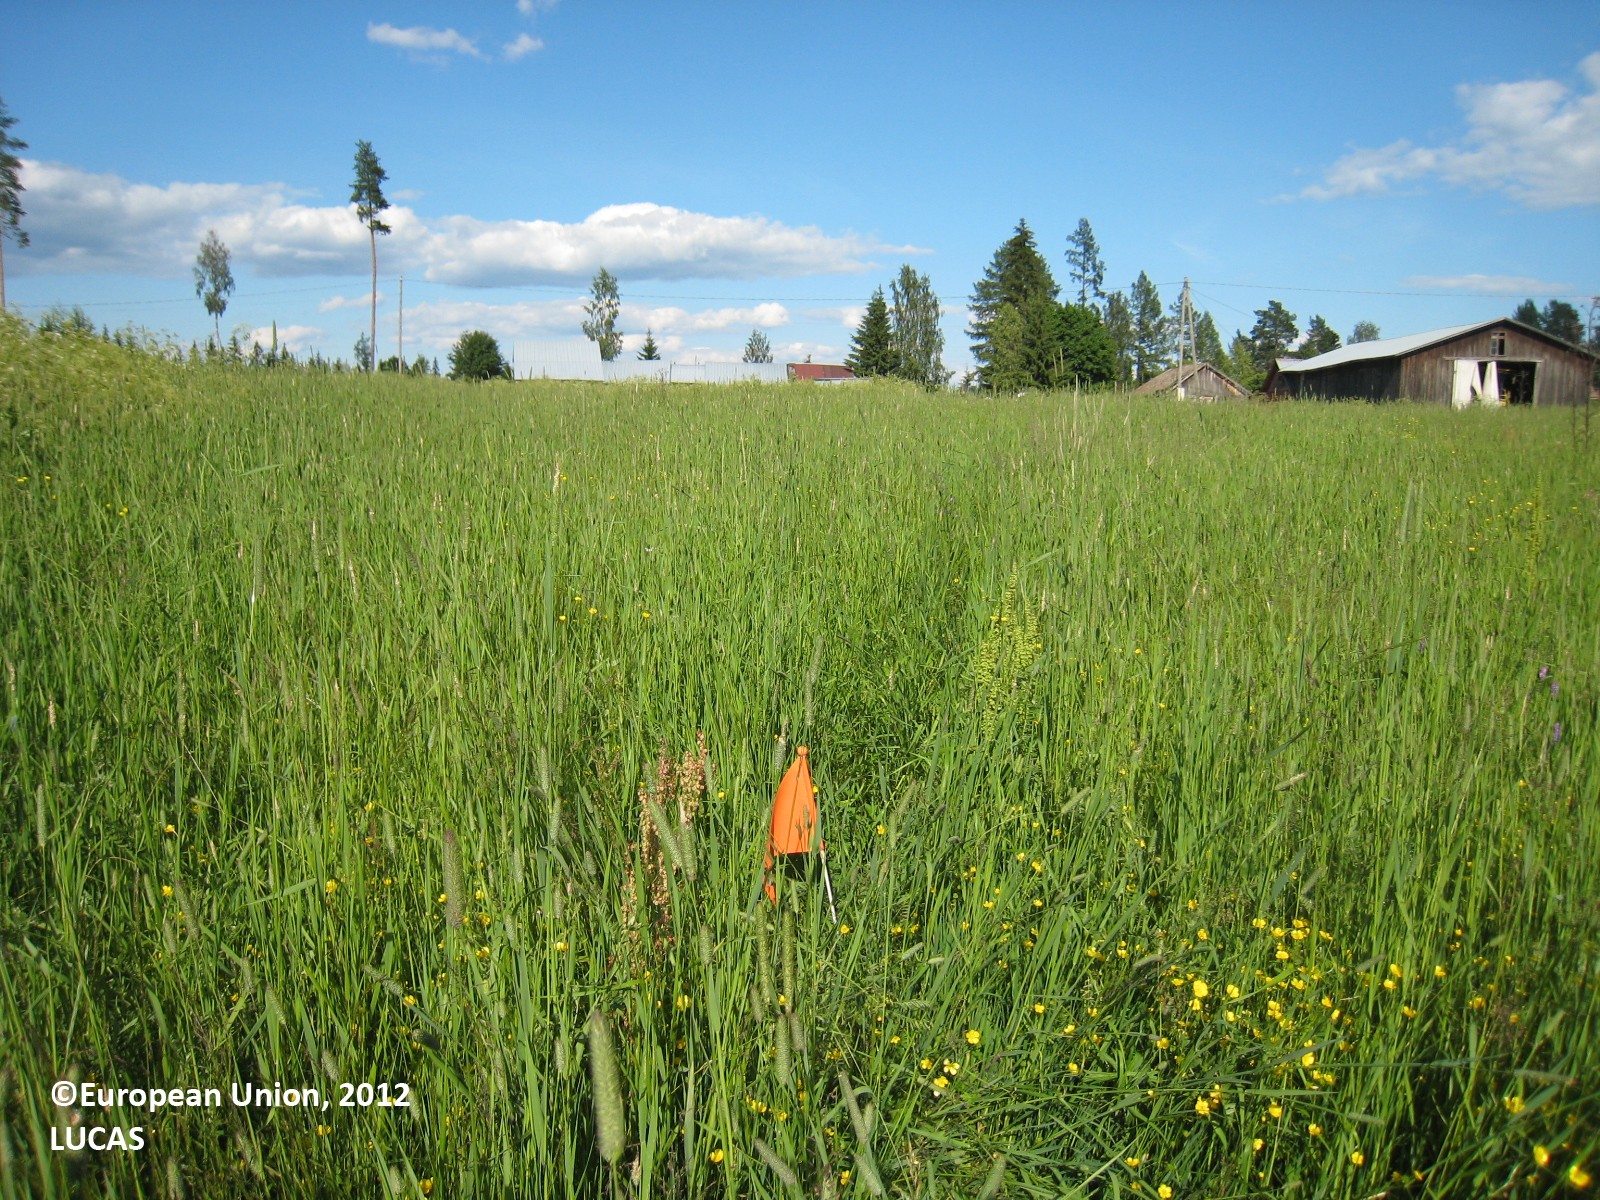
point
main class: Cropland
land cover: Temporary grasslands
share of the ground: > 75 %
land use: Agriculture (excluding fallow land and kitchen gardens)
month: July
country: FI
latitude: 62.6385
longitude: 26.1383
